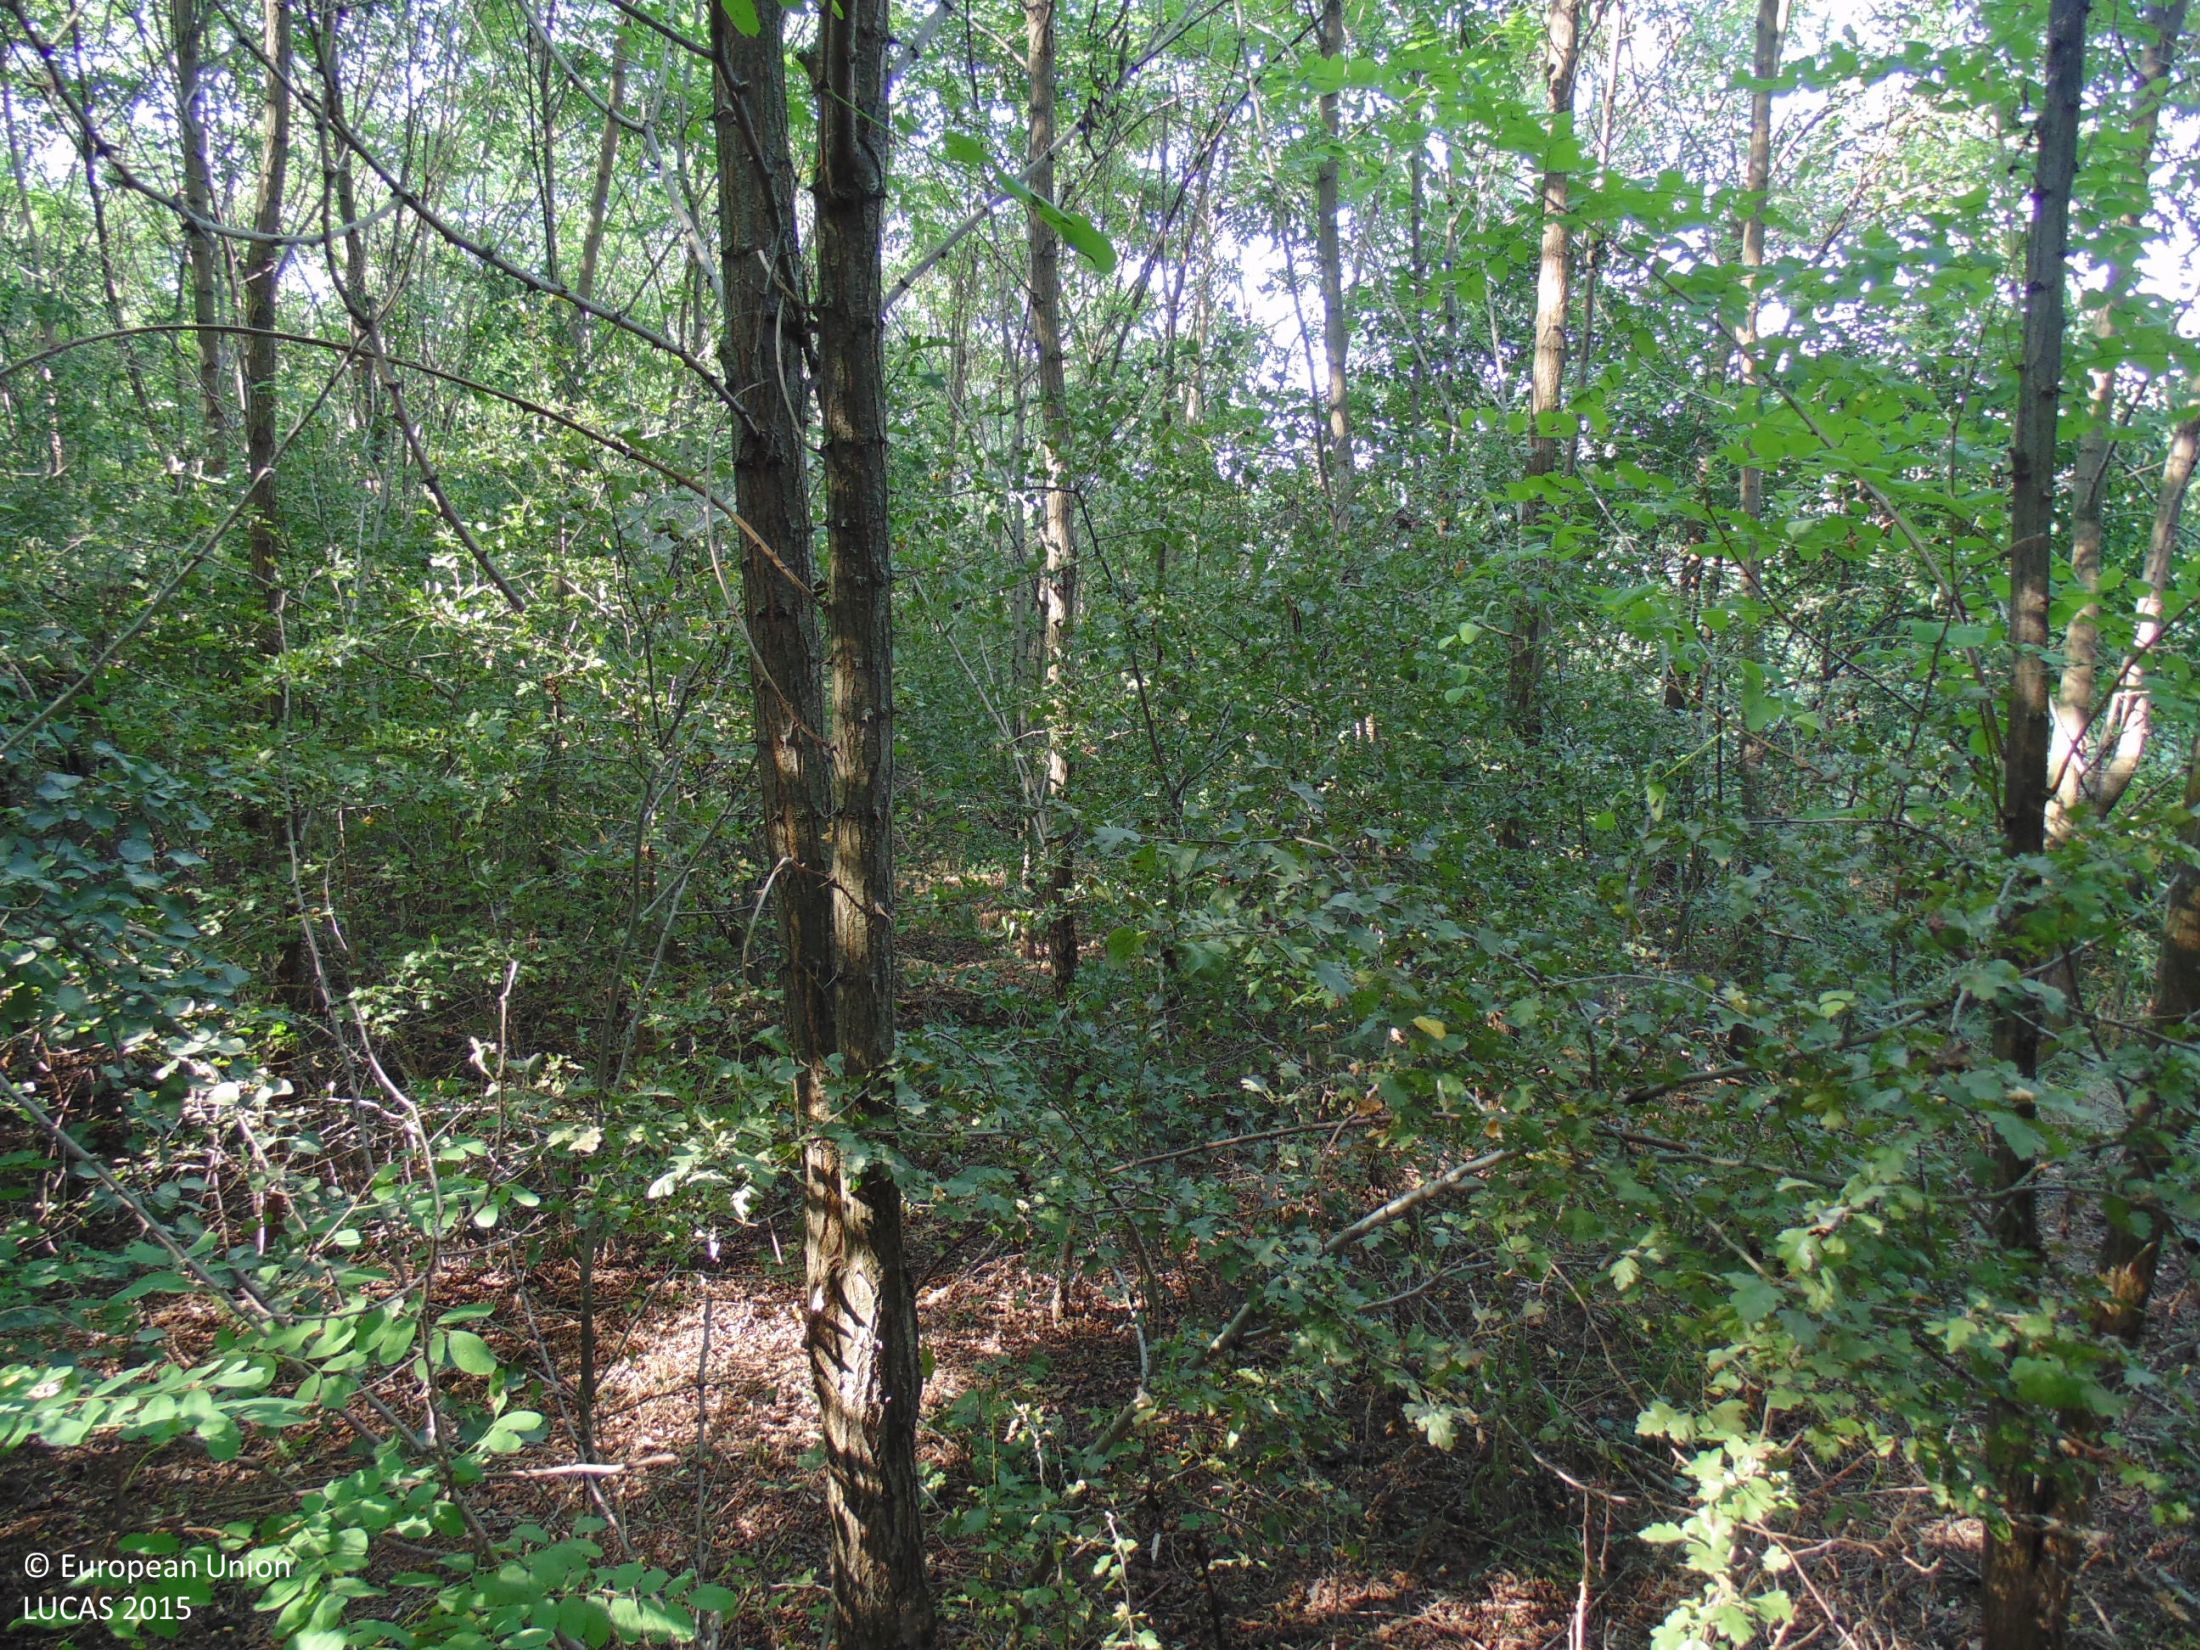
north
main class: Woodland
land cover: Broadleaved woodland
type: mesophytic deciduous forest
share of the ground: > 75 %
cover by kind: broadleaved forest trees 90 %, shrubs 5 %, unconsolidated bare surface 5 %
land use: Forestry
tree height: > 5 m
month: August
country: BG
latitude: 43.9238
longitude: 27.3574
